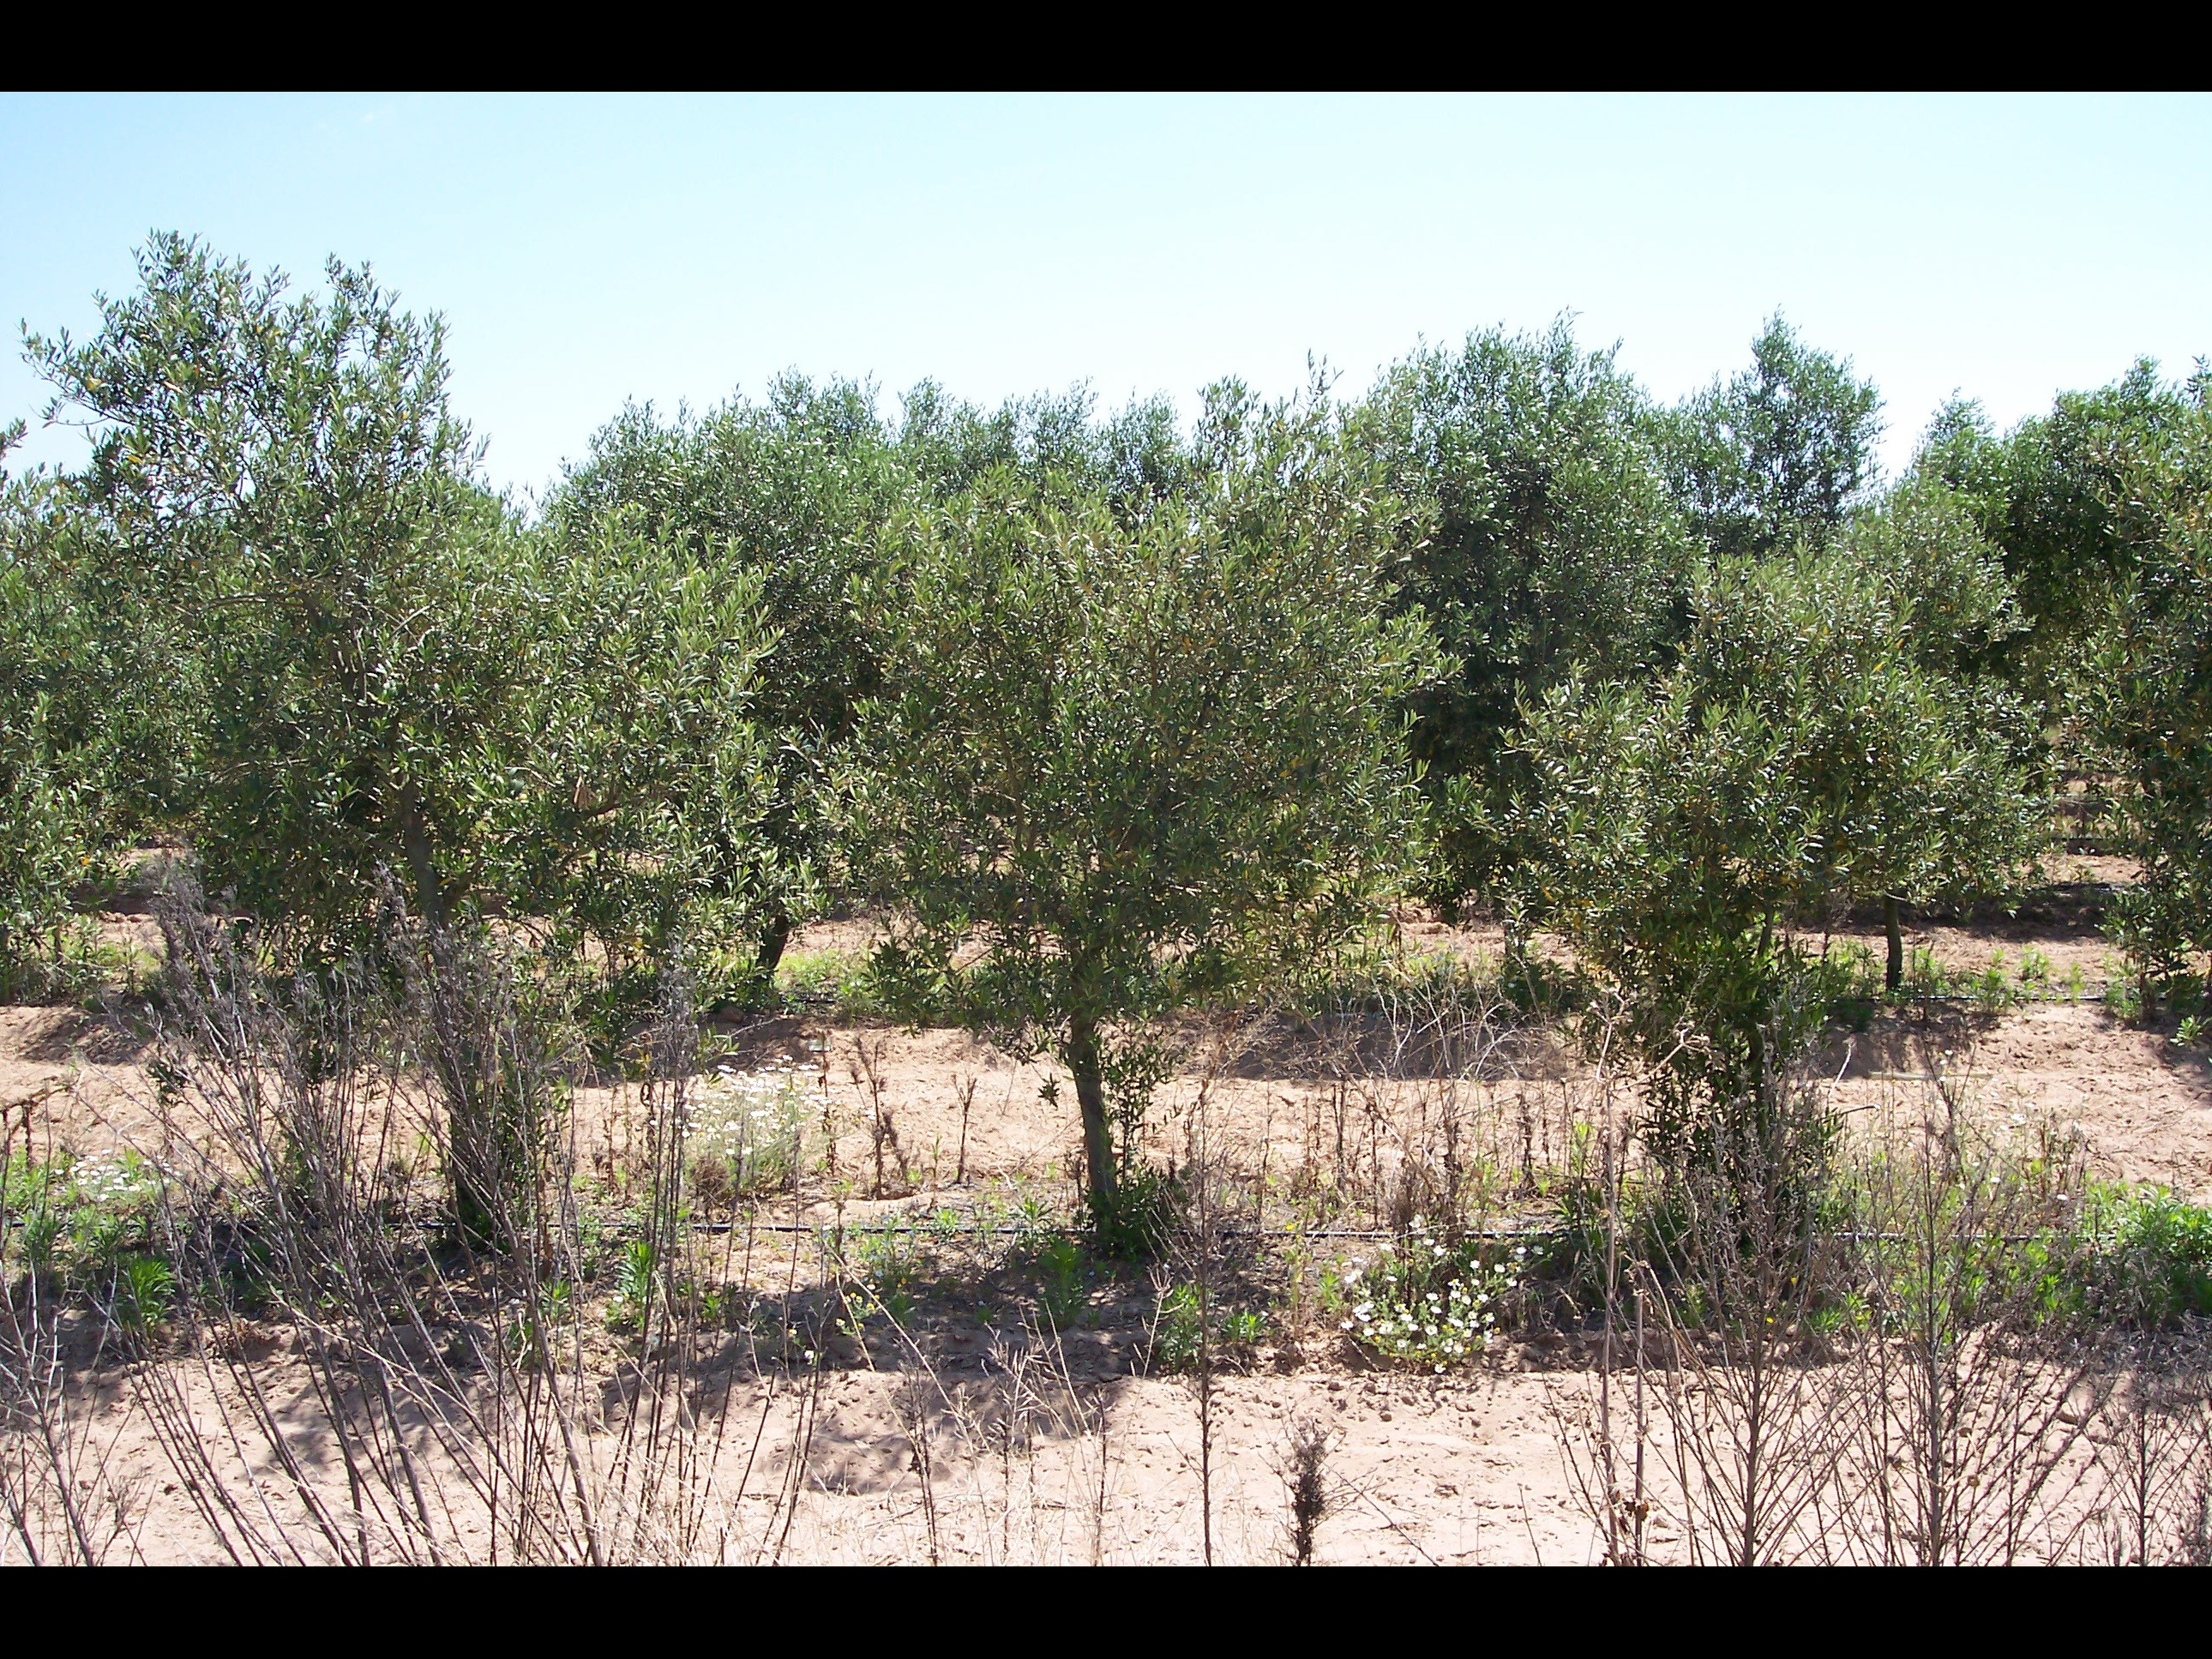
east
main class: Cropland
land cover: Olive groves
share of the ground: 25 - 50 %
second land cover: Spontaneously vegetated surfaces
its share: 10 - 25 %
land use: Agriculture (excluding fallow land and kitchen gardens)
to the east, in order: Olive groves; Spontaneously vegetated surfaces
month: May
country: ES
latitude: 37.2199
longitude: -5.8519
